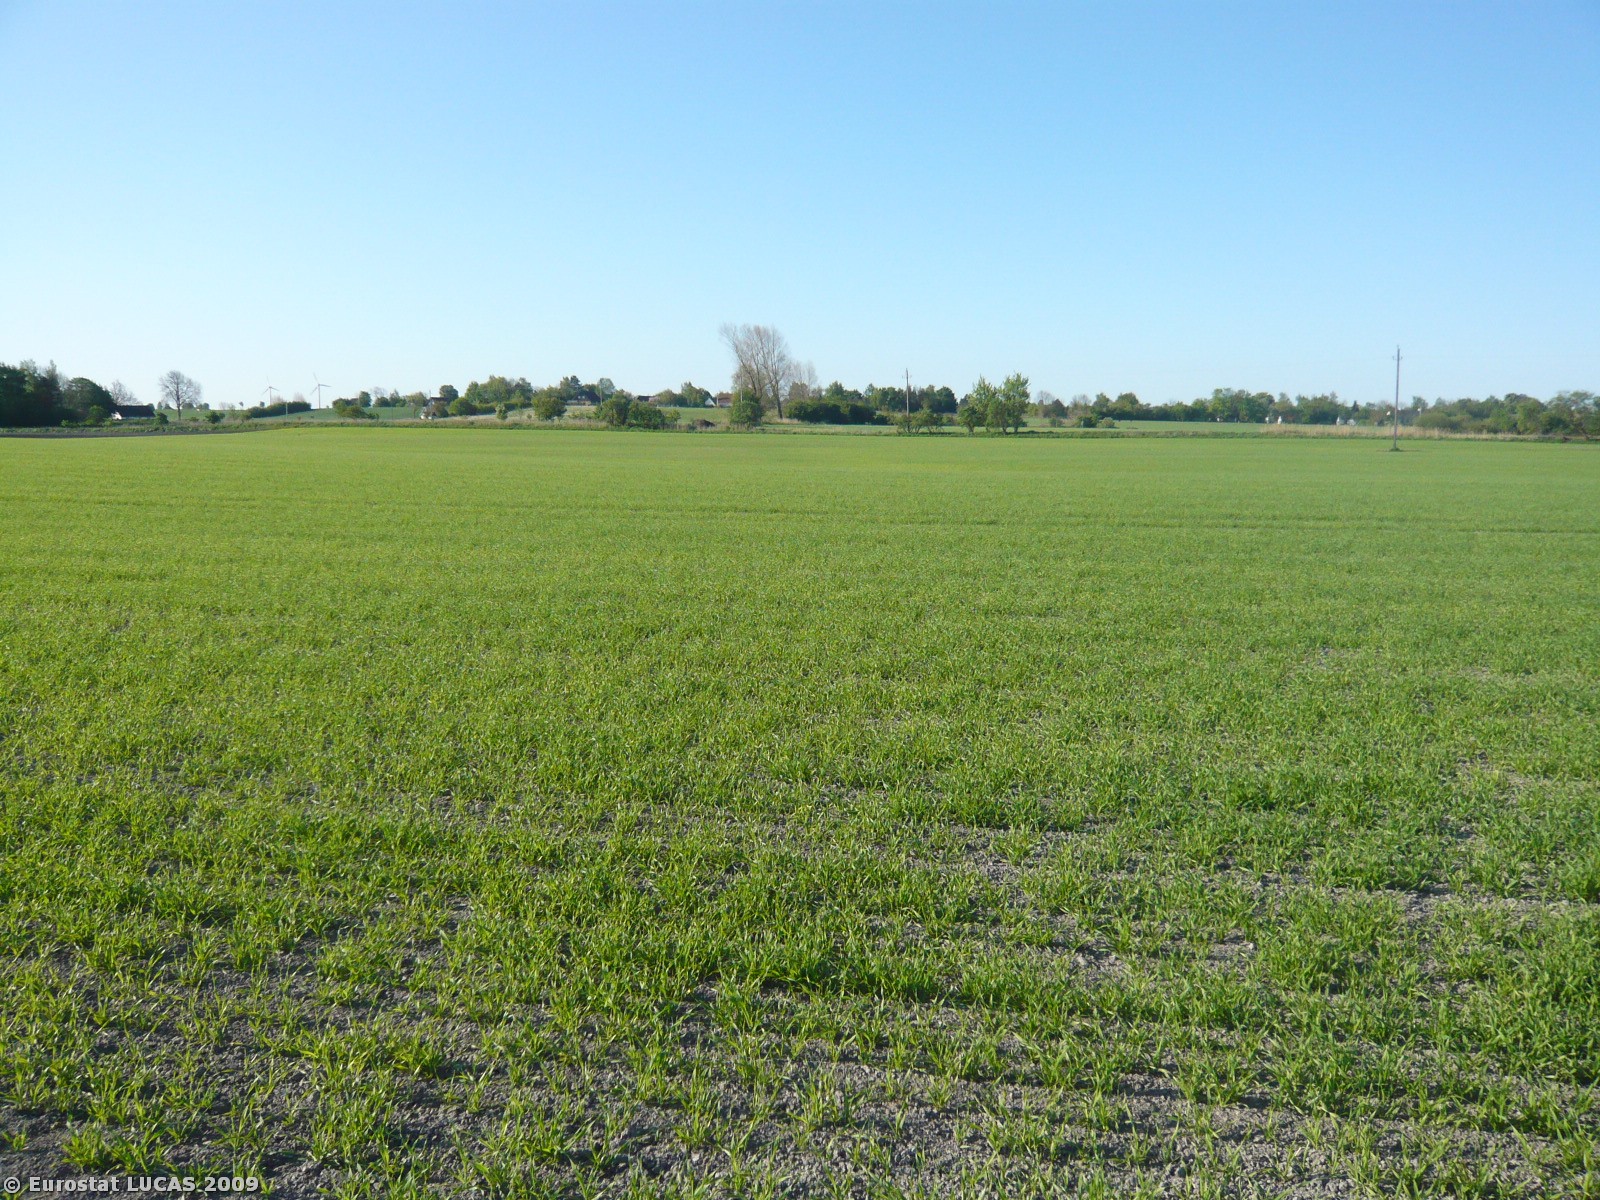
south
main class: Cropland
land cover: Common wheat
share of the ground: 25 - 50 %
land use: Agriculture (excluding fallow land and kitchen gardens)
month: May
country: DK
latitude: 55.0910
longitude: 12.1451
